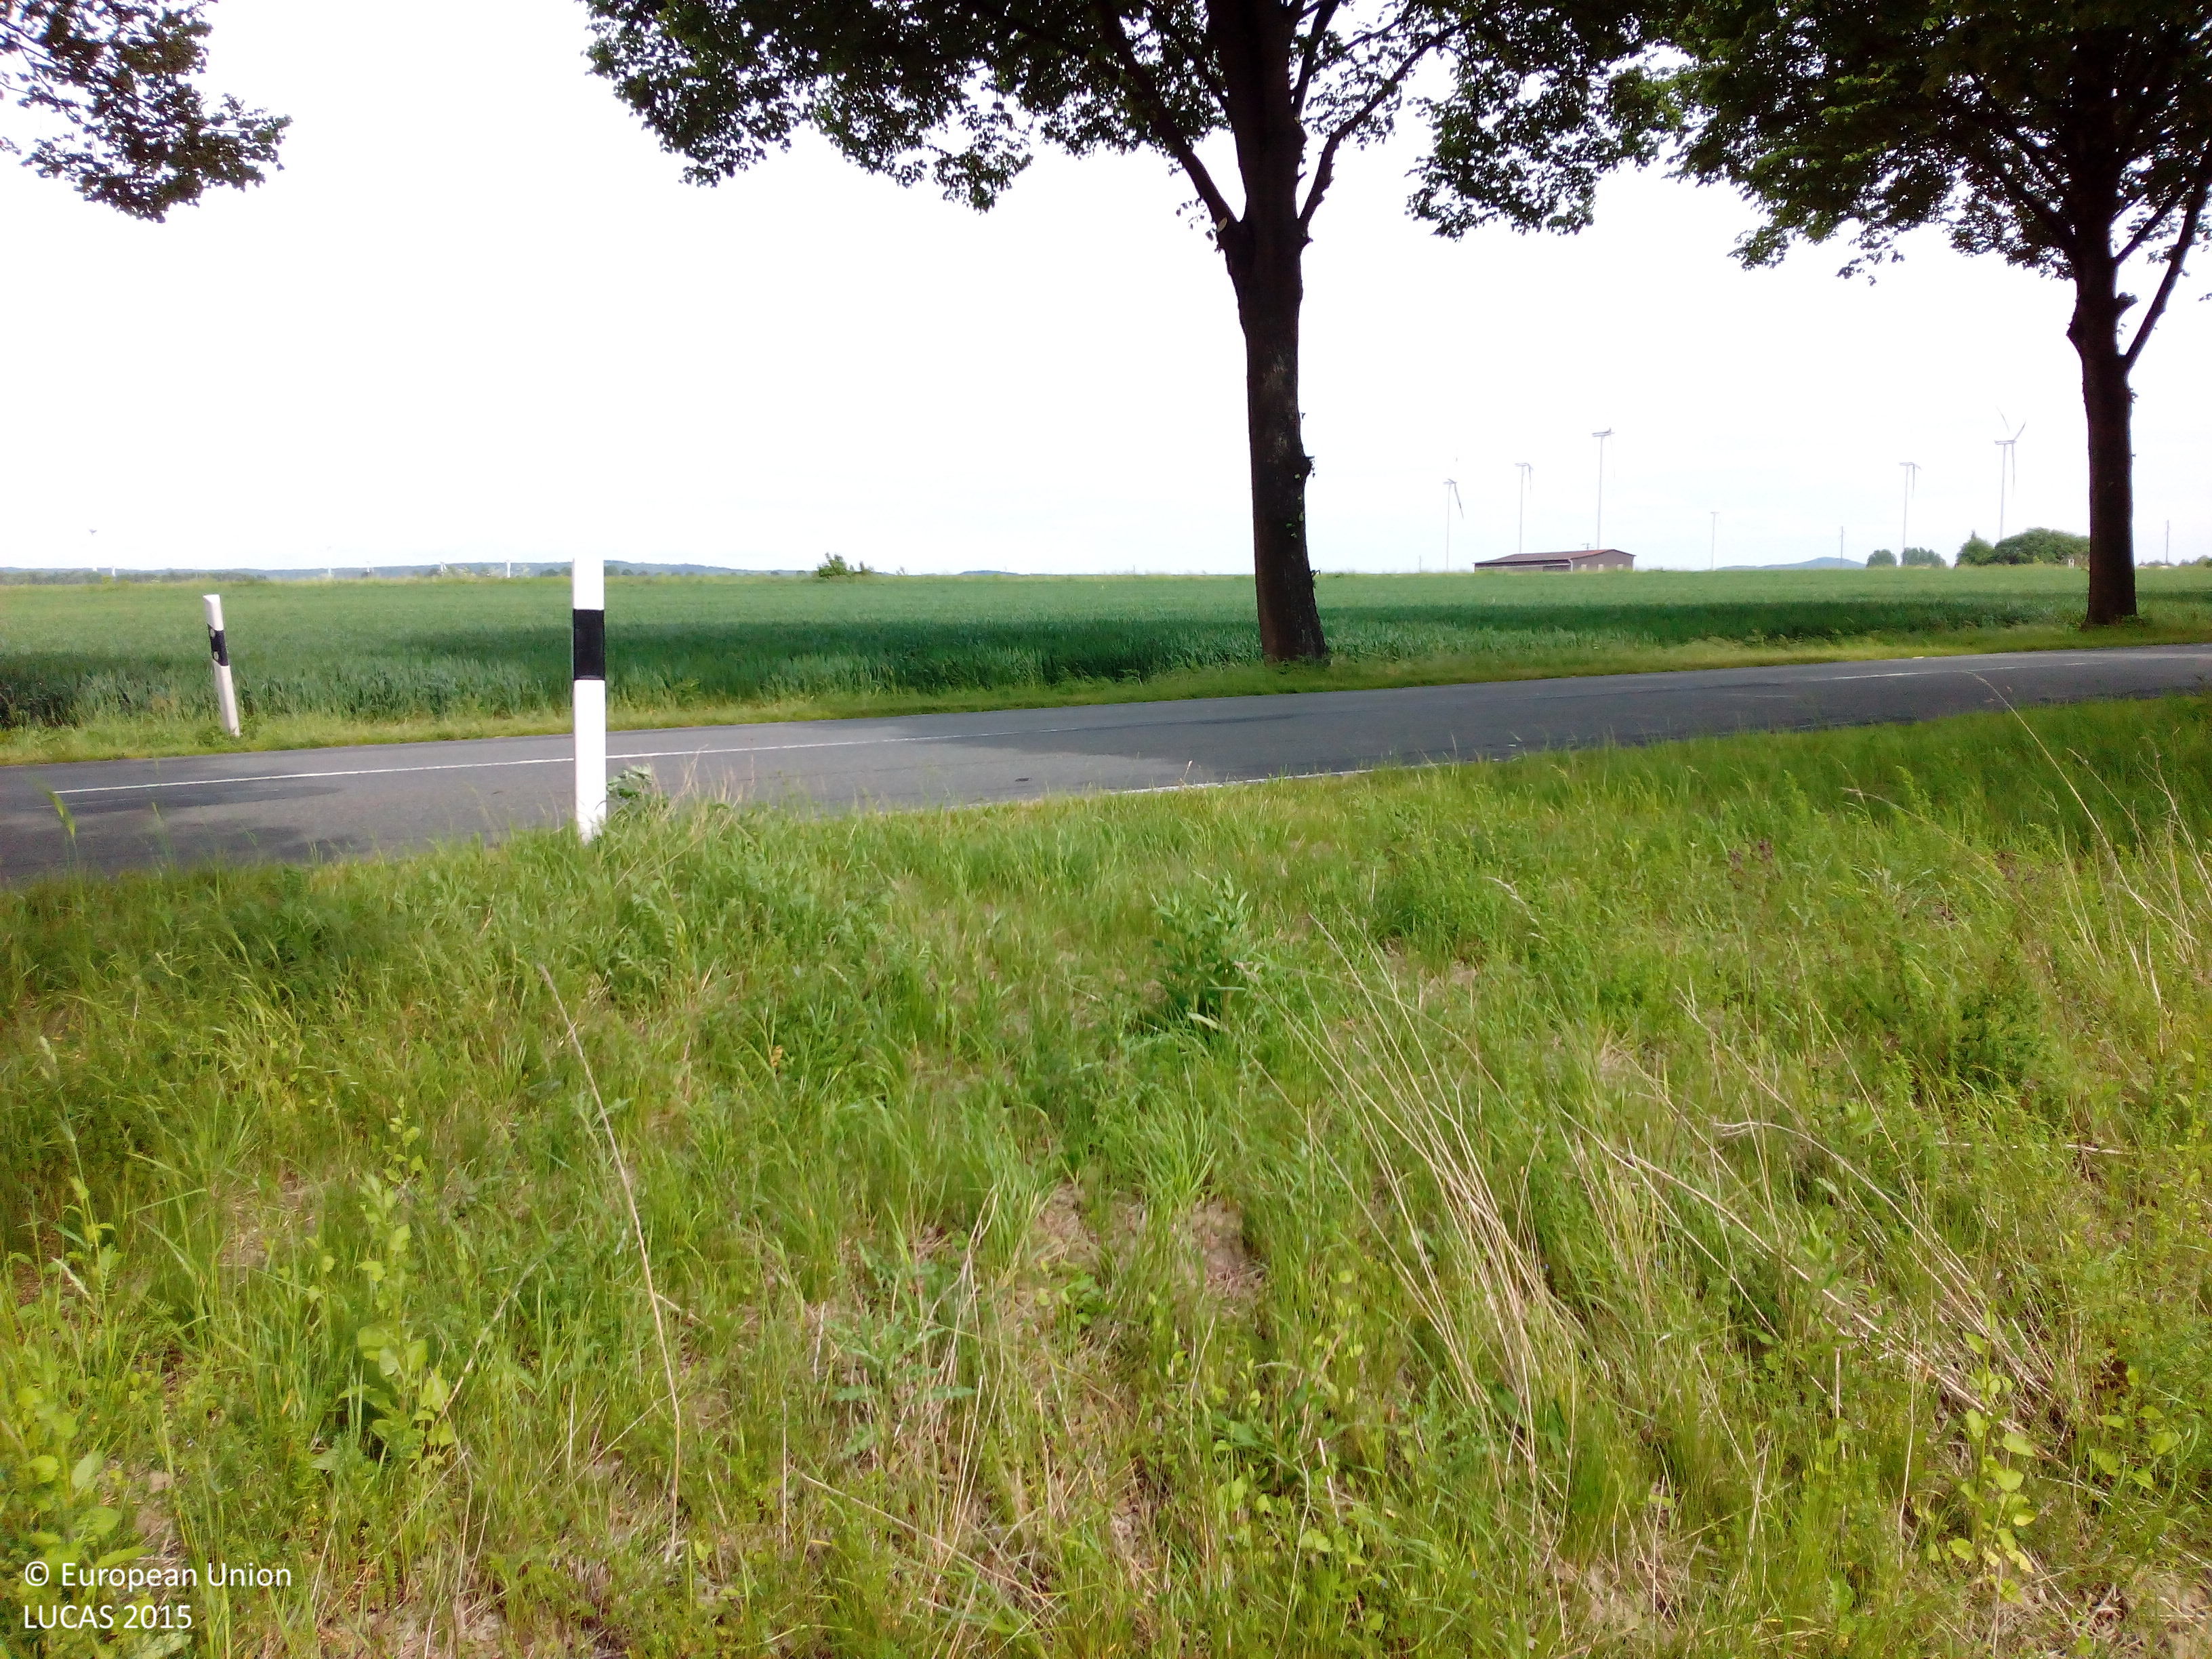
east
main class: Cropland
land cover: Sugar beet
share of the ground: 25 - 50 %
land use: Agriculture (excluding fallow land and kitchen gardens)
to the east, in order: Sugar beet; Common wheat; Lines of trees; Grass margins; Paved roads, cycling and walking lanes; Grass margins; Lines of trees; Ditches and canals; Grass margins; Barley
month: May
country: DE
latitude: 52.0536
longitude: 10.2770
